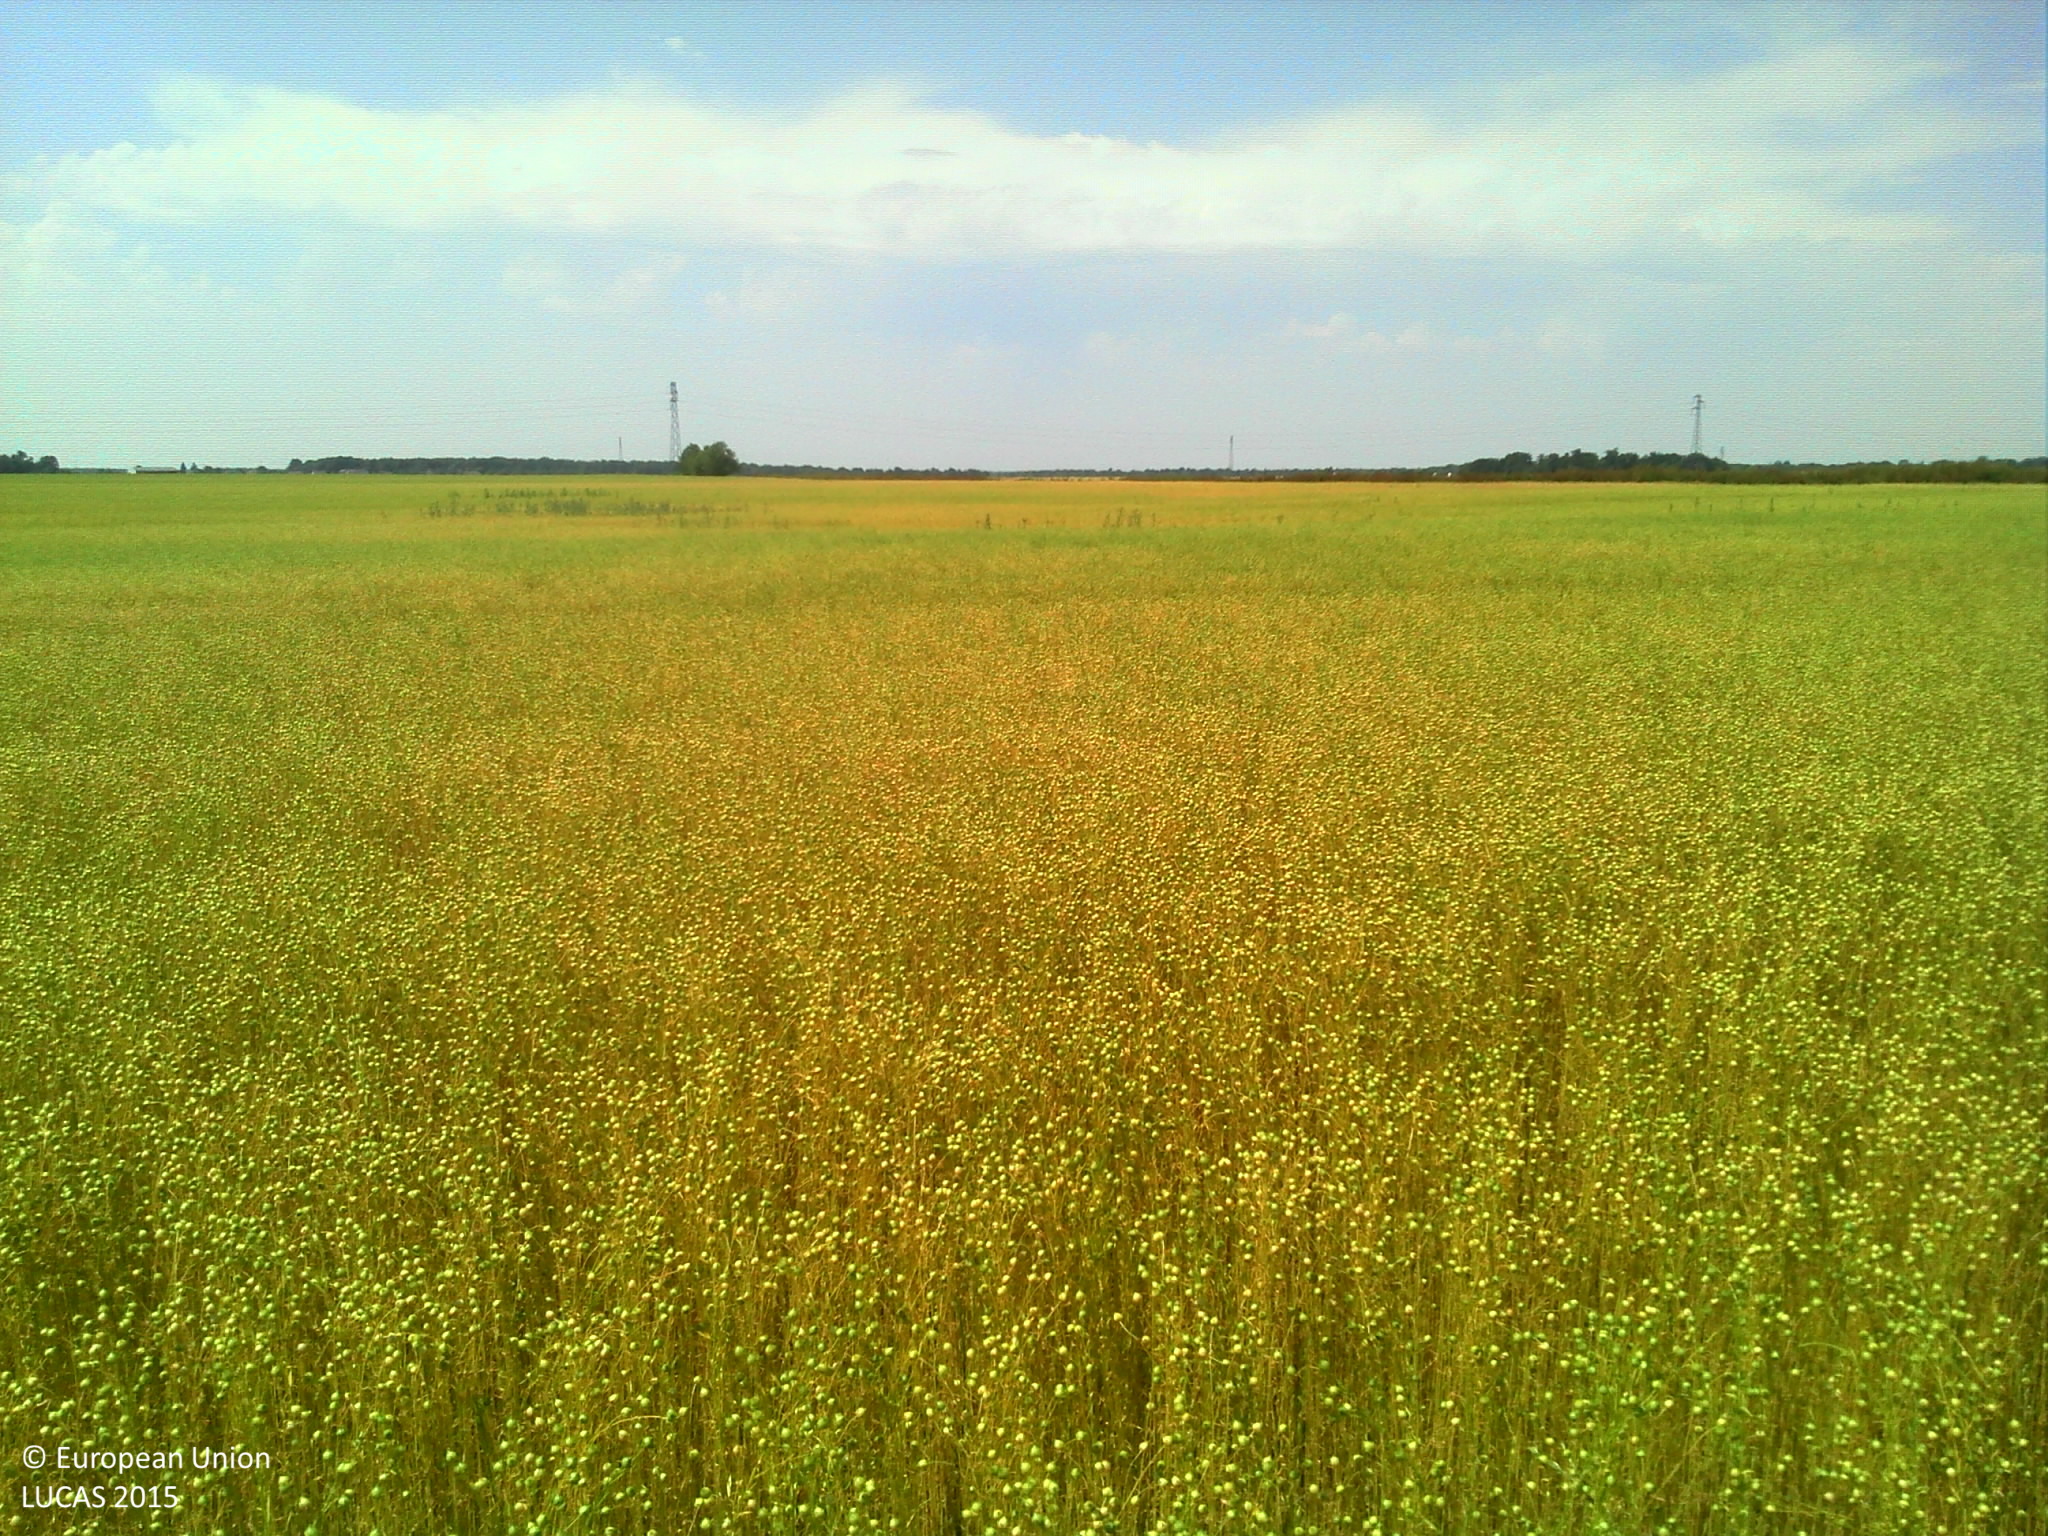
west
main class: Cropland
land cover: Other fibre and oleaginous crops
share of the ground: > 75 %
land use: Agriculture (excluding fallow land and kitchen gardens)
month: July
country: FR
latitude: 48.9568
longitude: 1.1986
